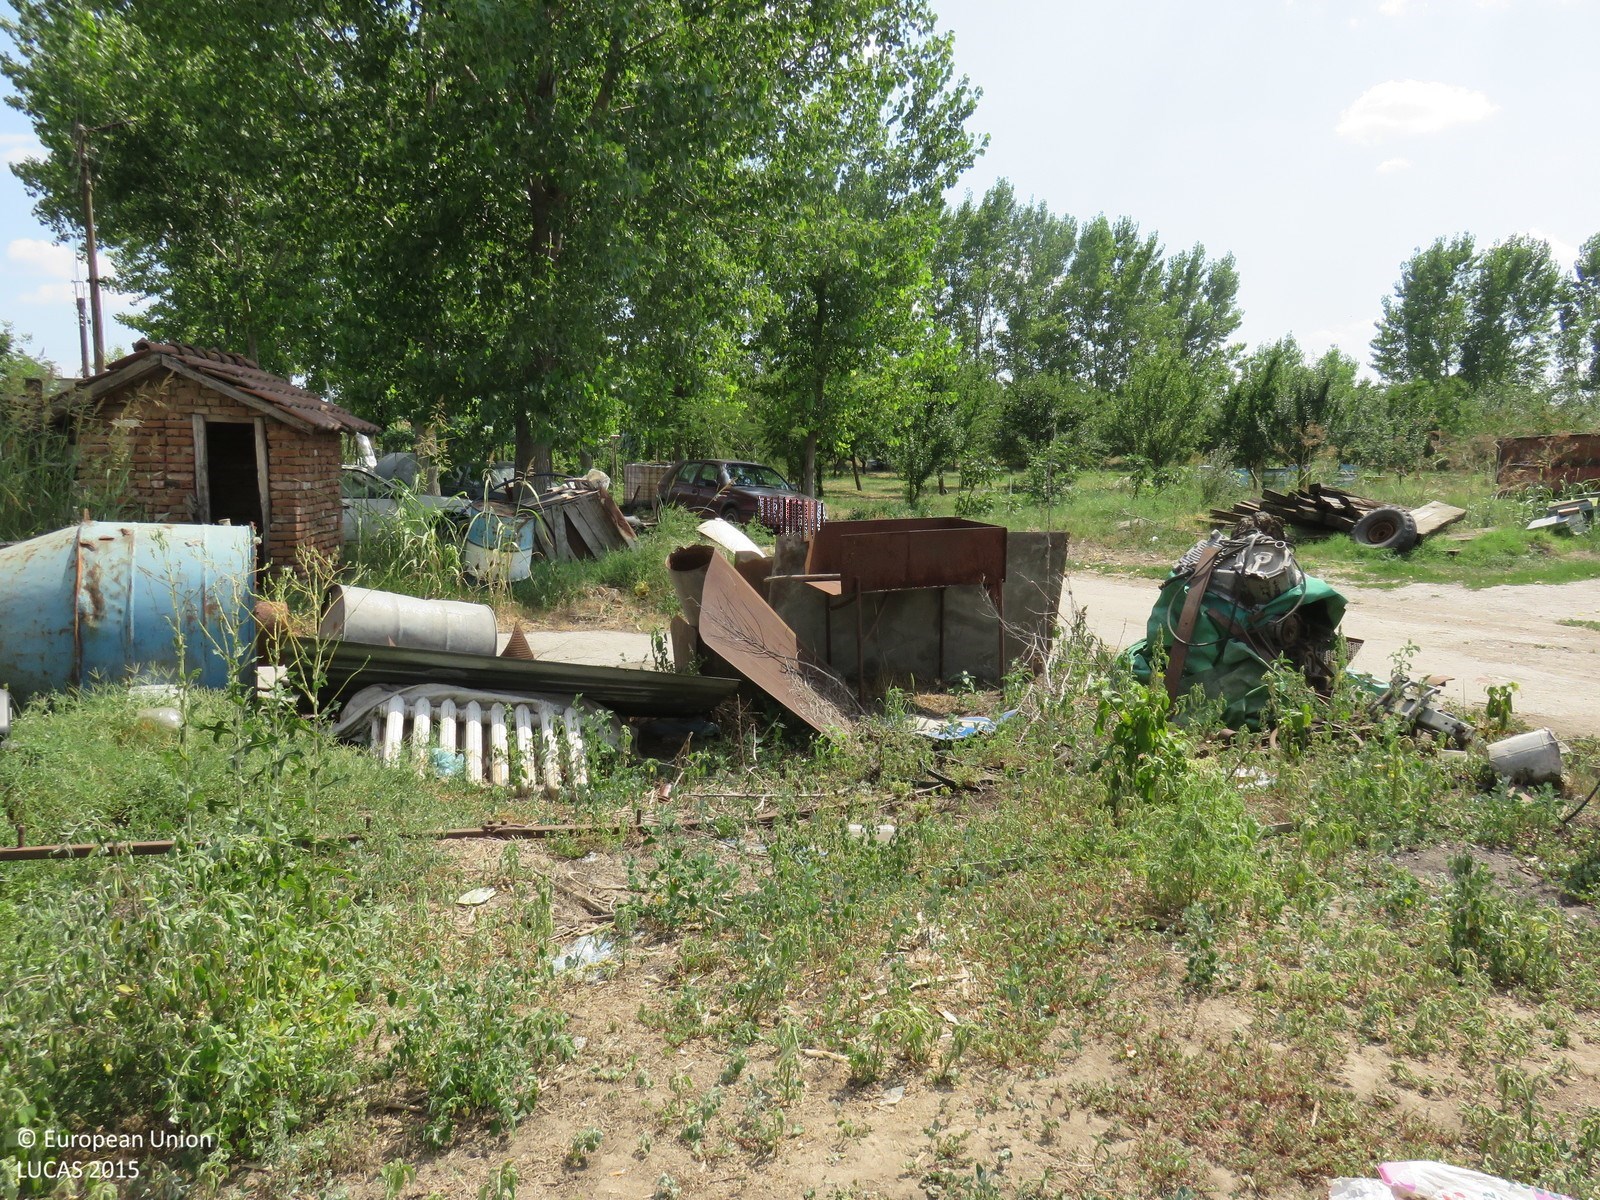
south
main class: Grassland
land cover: Spontaneously vegetated surfaces
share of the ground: > 75 %
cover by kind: herbaceous plants 90 %, unconsolidated bare surface 10 %
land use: Agriculture (excluding fallow land and kitchen gardens)
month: July
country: BG
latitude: 43.4207
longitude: 25.1040
